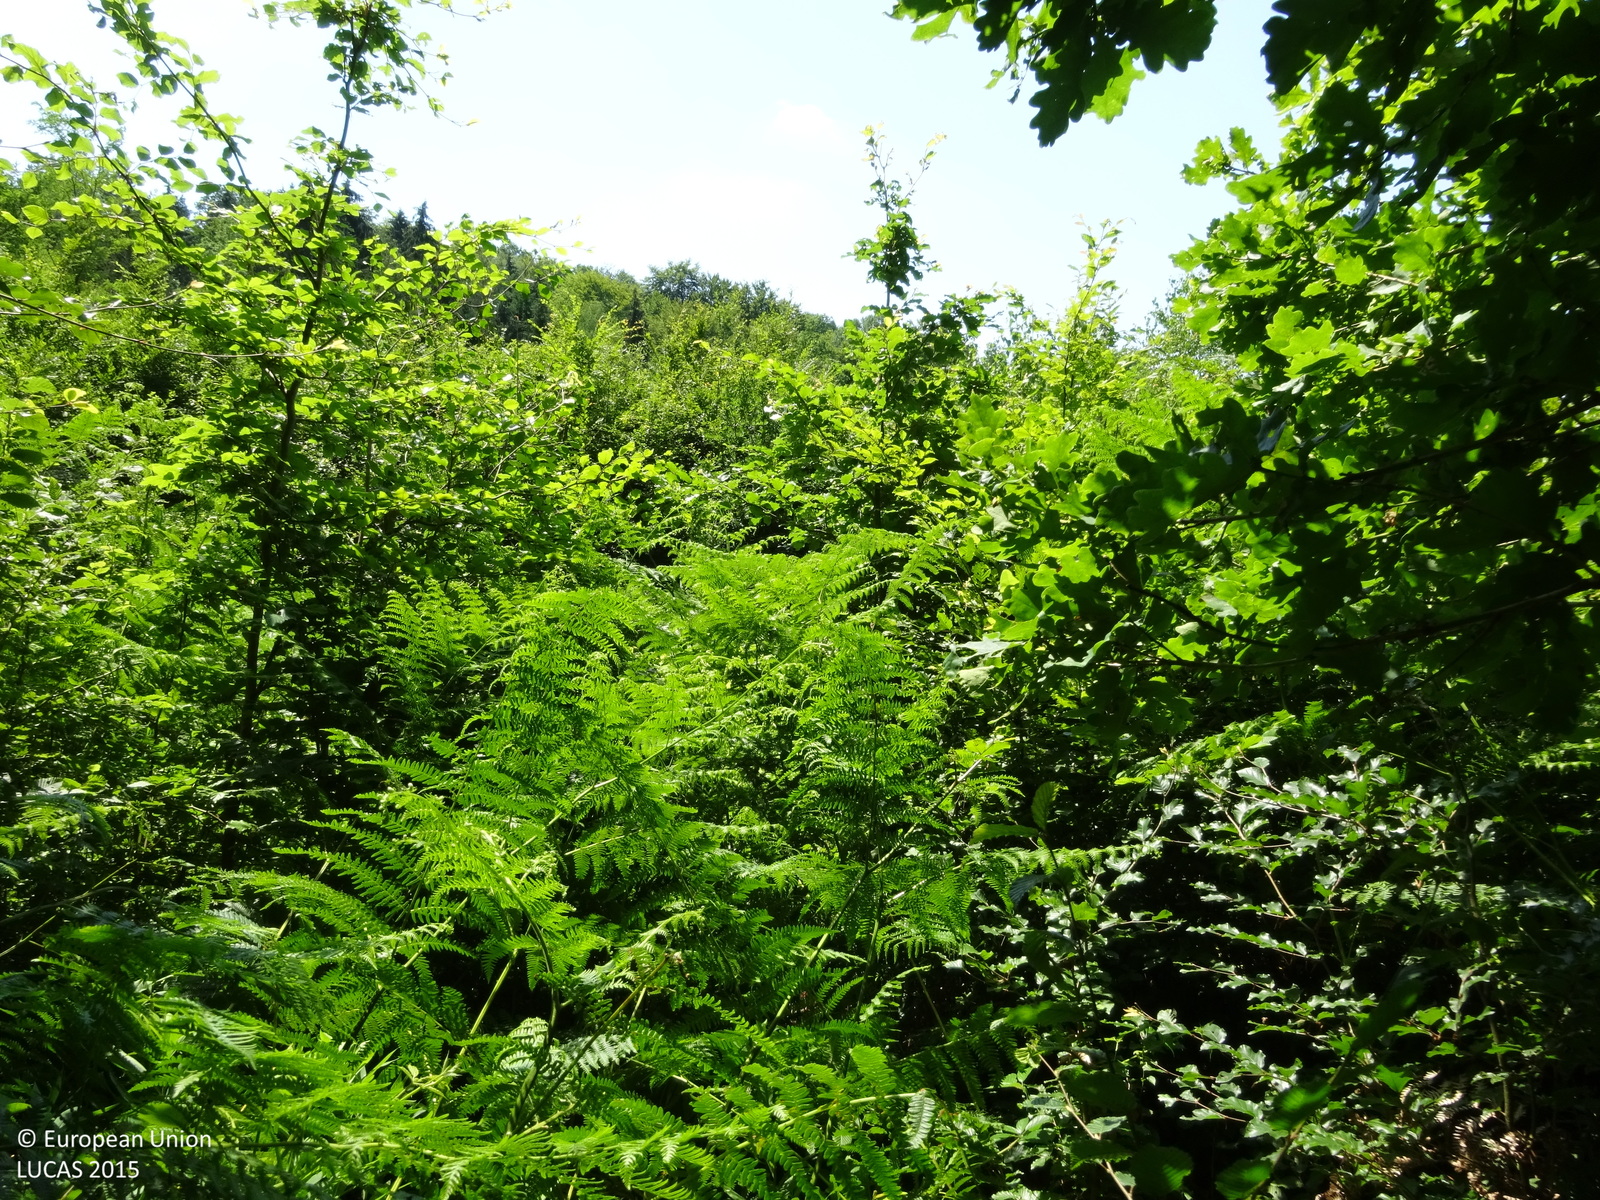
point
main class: Shrubland
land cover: Shrubland with sparse tree cover
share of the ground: > 75 %
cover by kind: shrubs 95 %, broadleaved forest trees 5 %
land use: Forestry
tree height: > 5 m
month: July
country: AT
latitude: 46.8797
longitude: 16.1289
